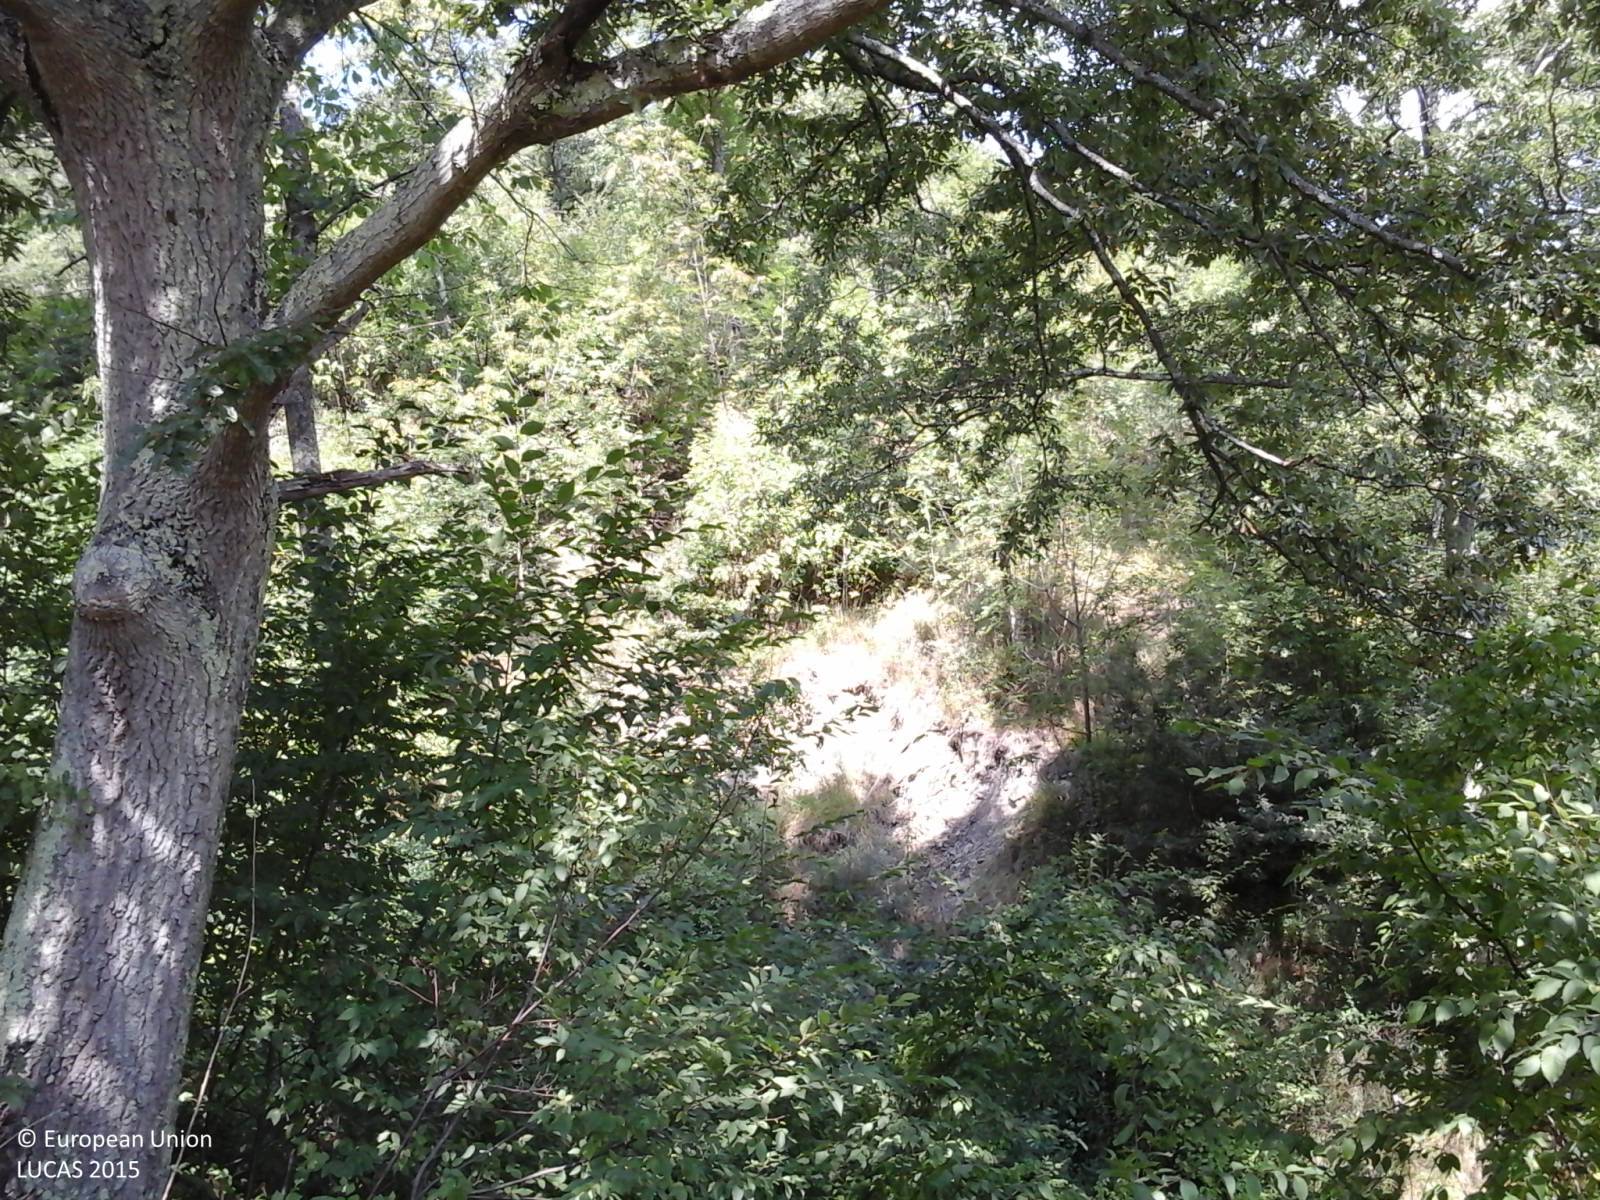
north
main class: Woodland
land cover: Broadleaved woodland
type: thermophilous deciduous forest
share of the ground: > 75 %
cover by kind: broadleaved forest trees 85 %, shrubs 15 %
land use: Forestry
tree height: > 5 m
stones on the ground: < 10 %
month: August
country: IT
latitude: 43.6252
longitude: 12.1137
